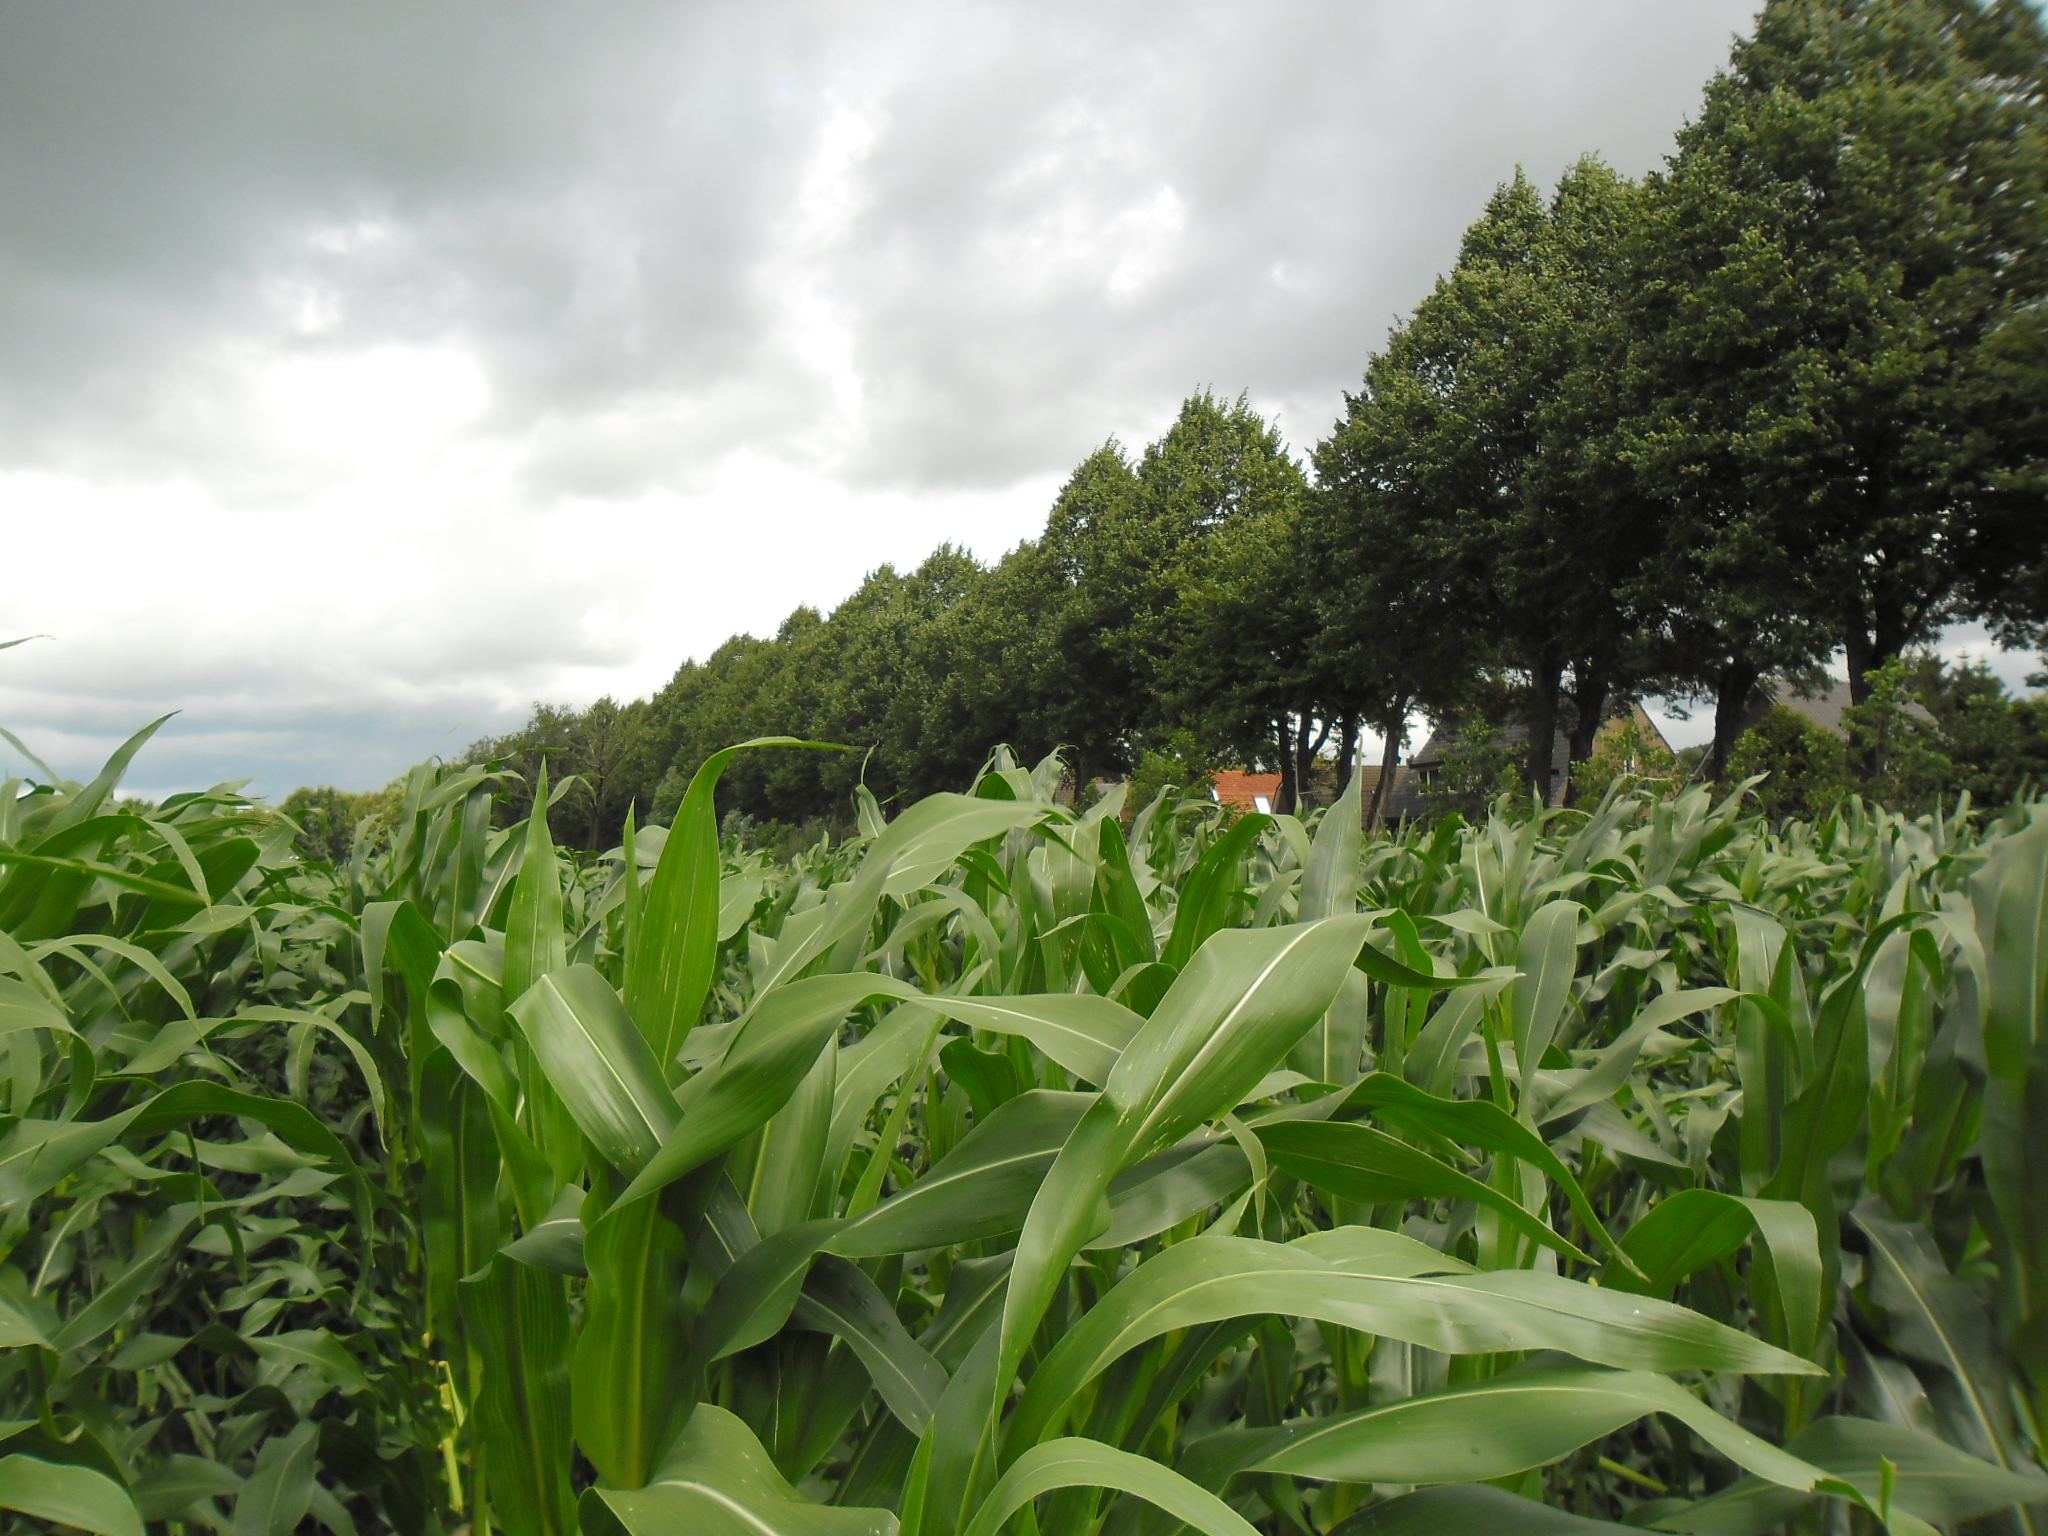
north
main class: Cropland
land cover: Maize
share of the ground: > 75 %
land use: Agriculture (excluding fallow land and kitchen gardens)
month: July
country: NL
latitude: 52.7294
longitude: 6.1642
